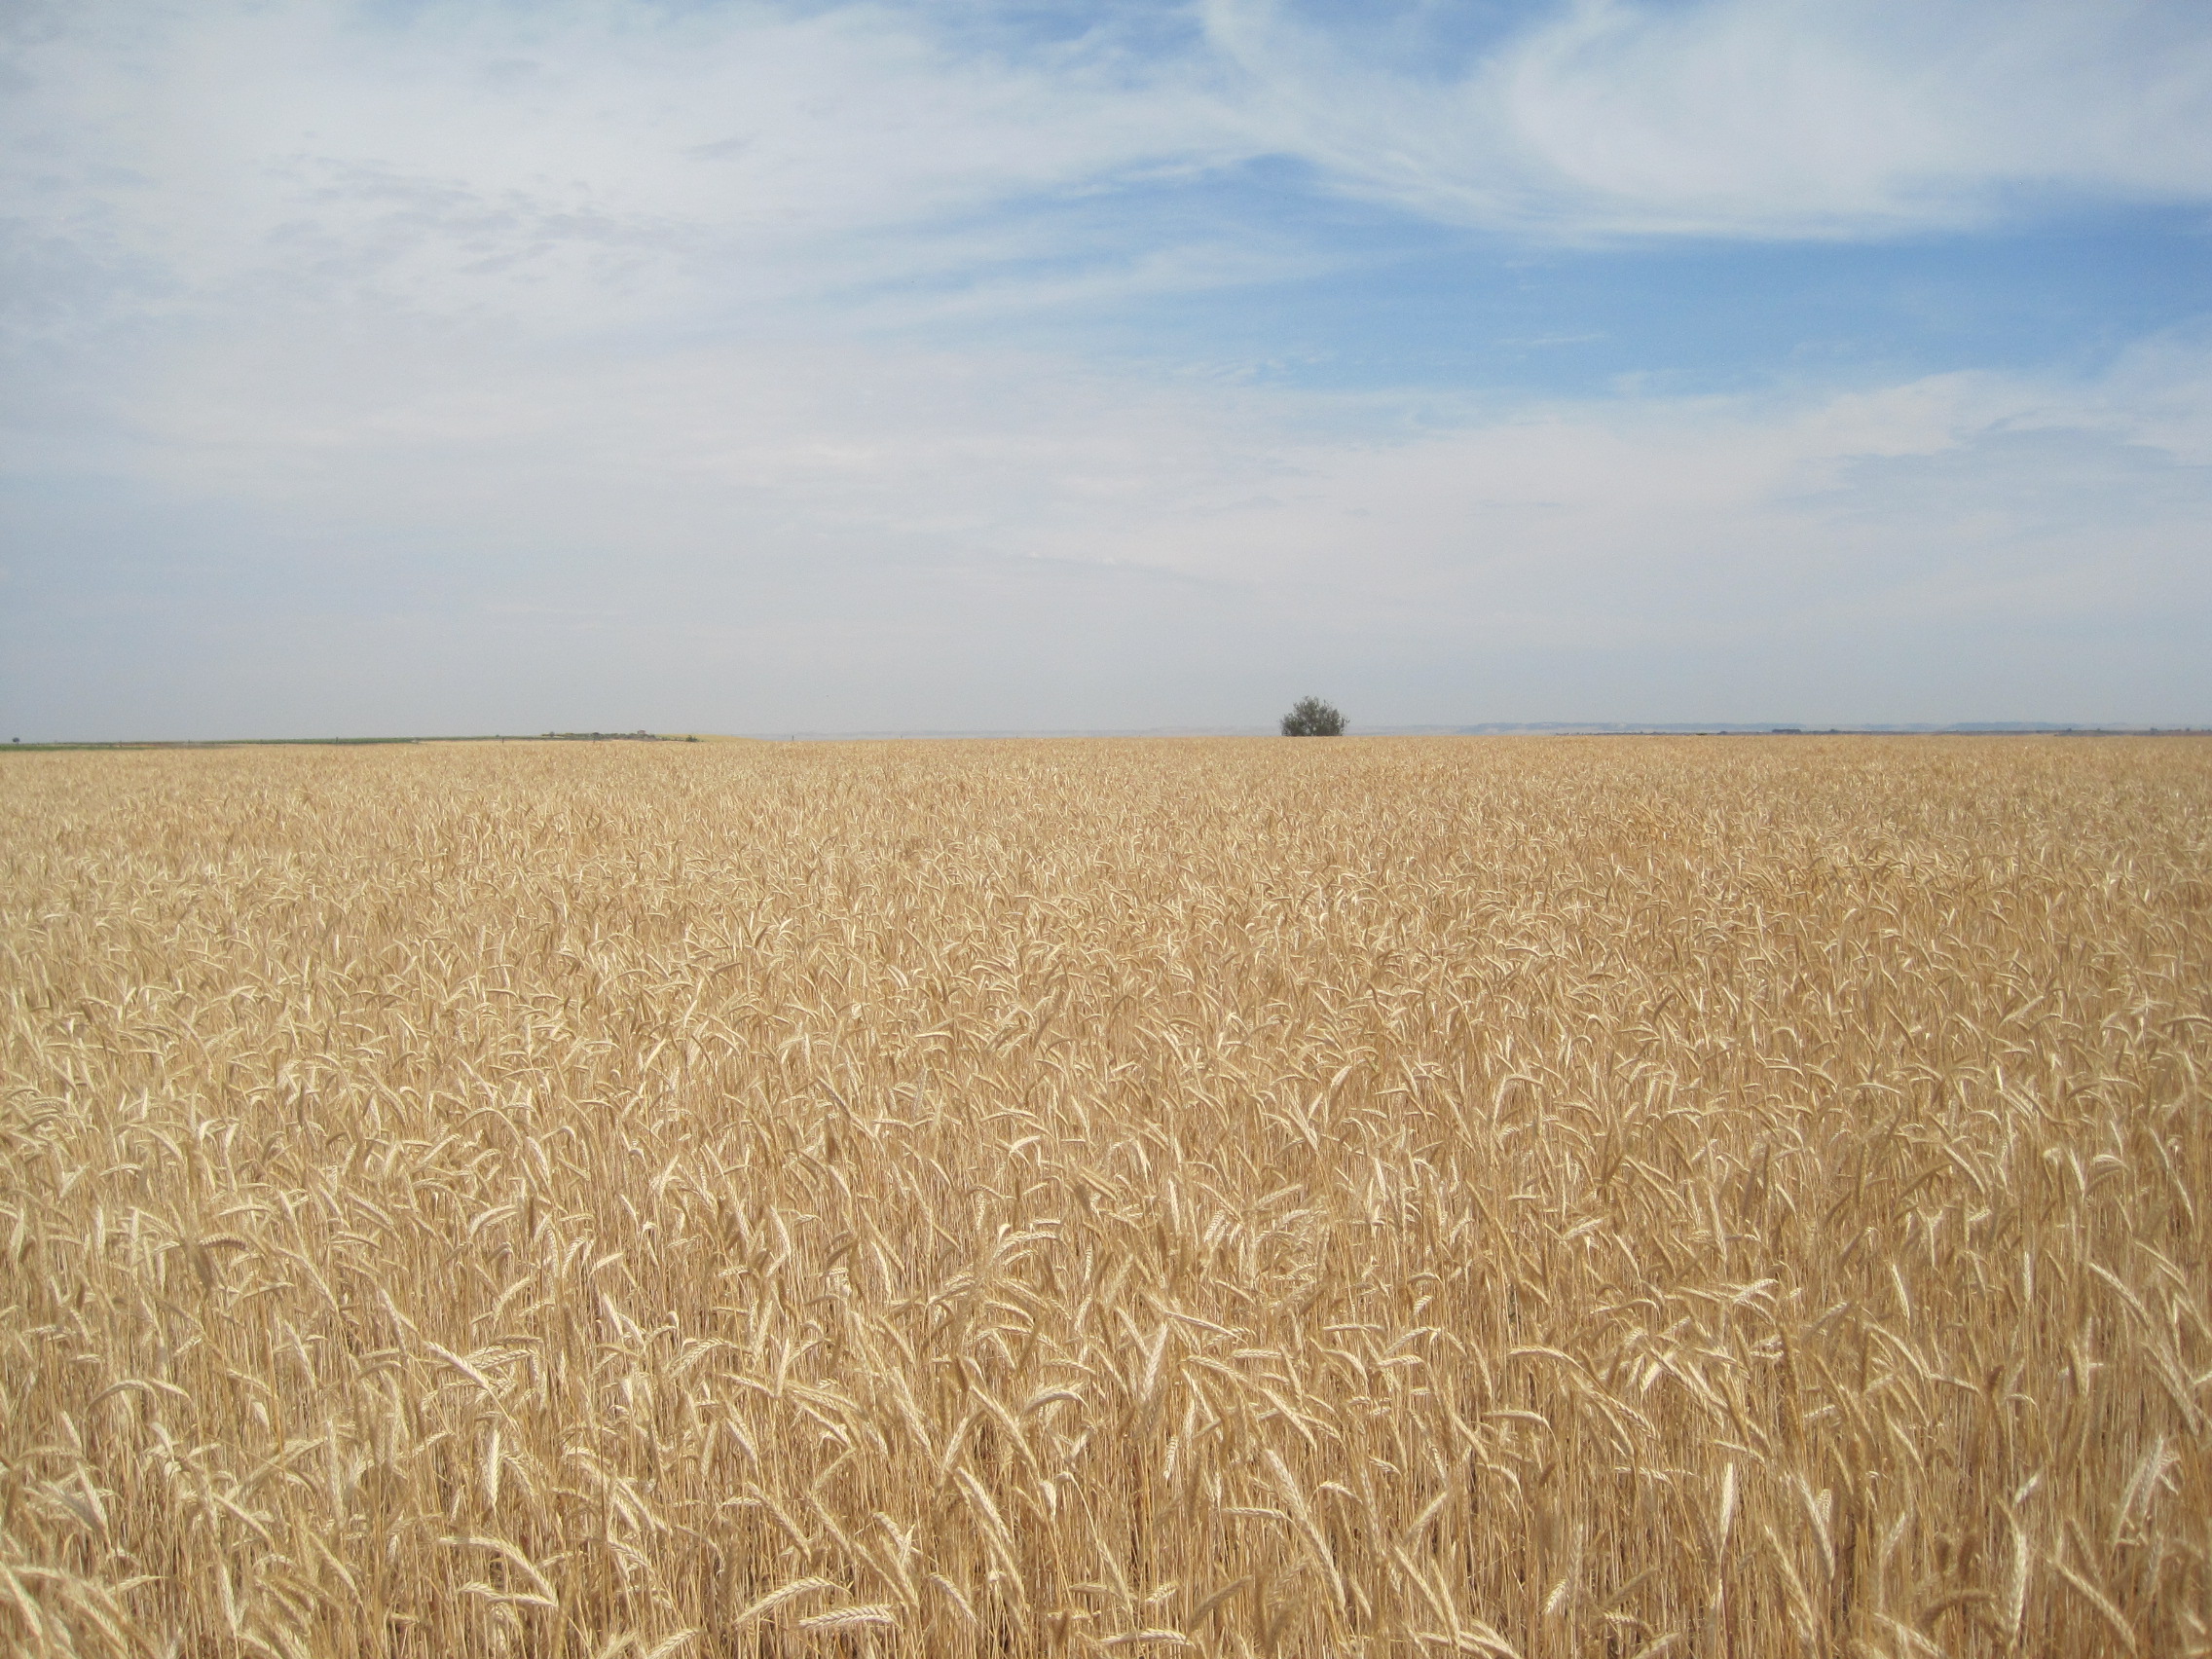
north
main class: Cropland
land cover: Triticale
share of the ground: > 75 %
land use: Agriculture (excluding fallow land and kitchen gardens)
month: June
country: ES
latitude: 41.3501
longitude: -5.0954
